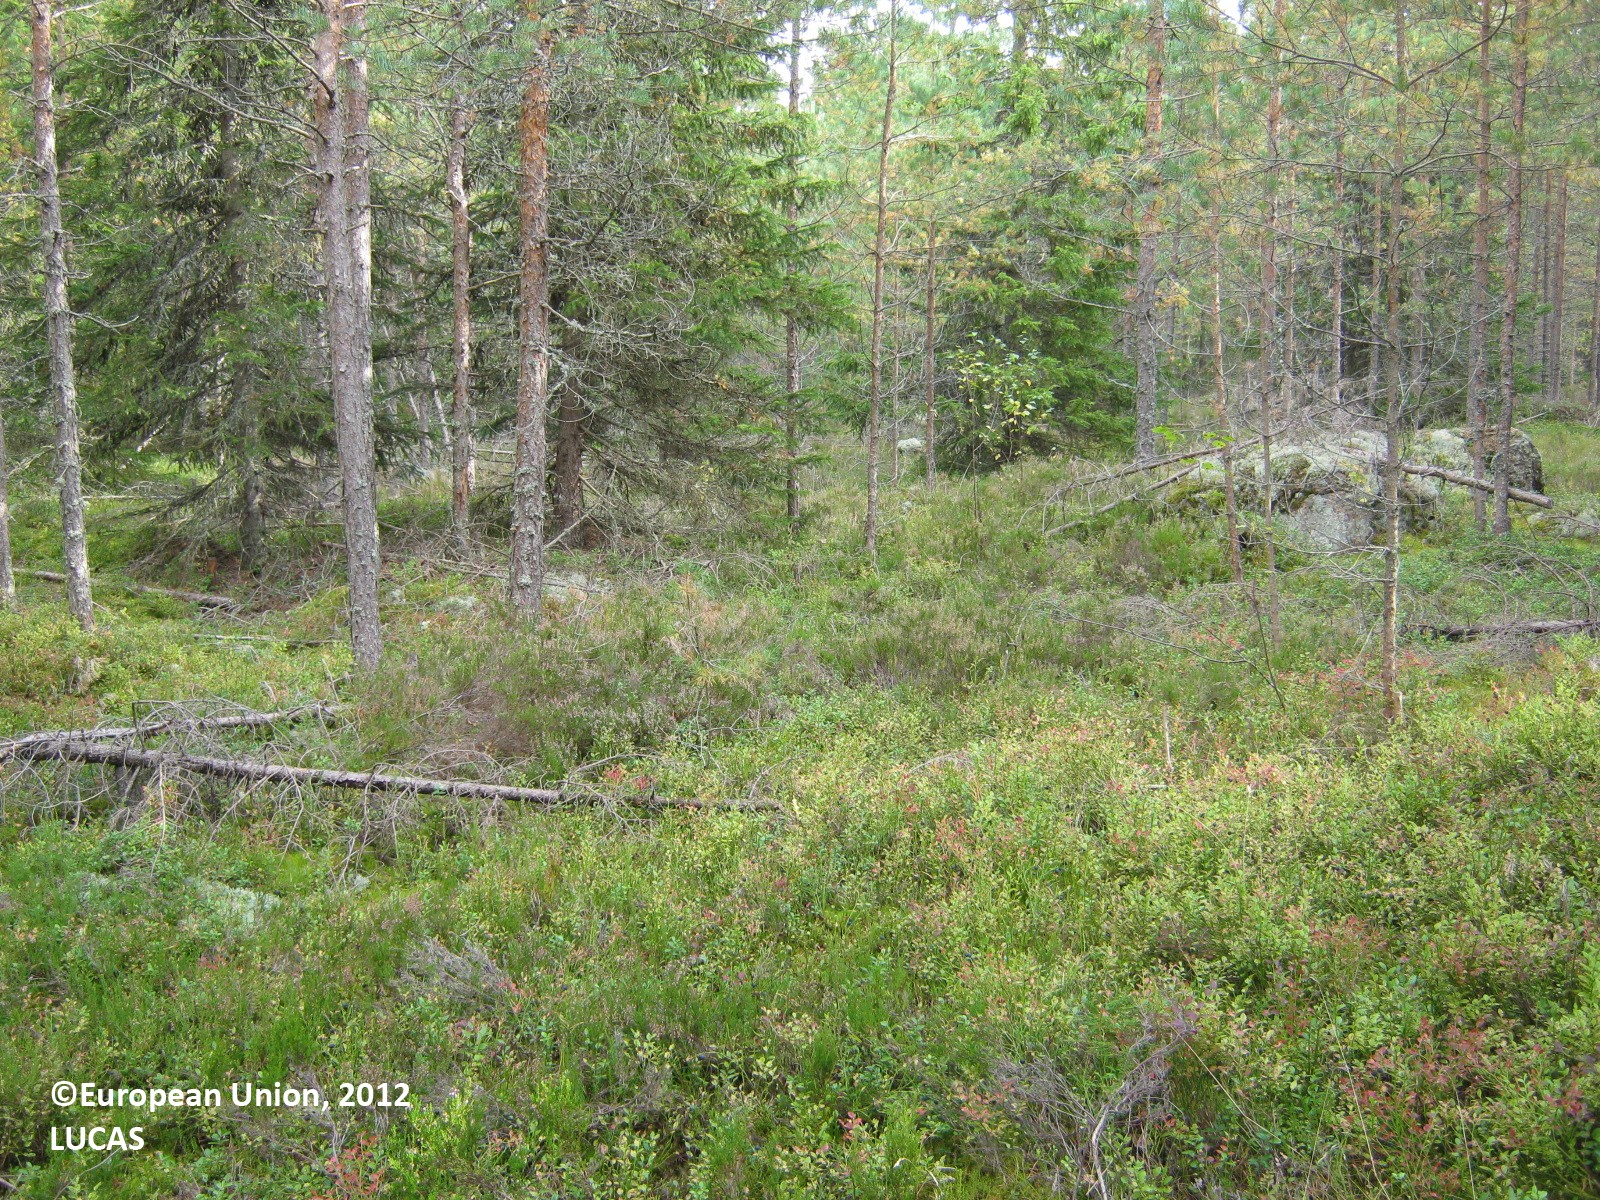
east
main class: Woodland
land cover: Other coniferous woodland
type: boreal forest
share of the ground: 50 - 75 %
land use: Forestry
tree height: > 5 m
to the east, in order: Other coniferous woodland
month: September
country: FI
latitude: 60.6152
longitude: 27.7518
